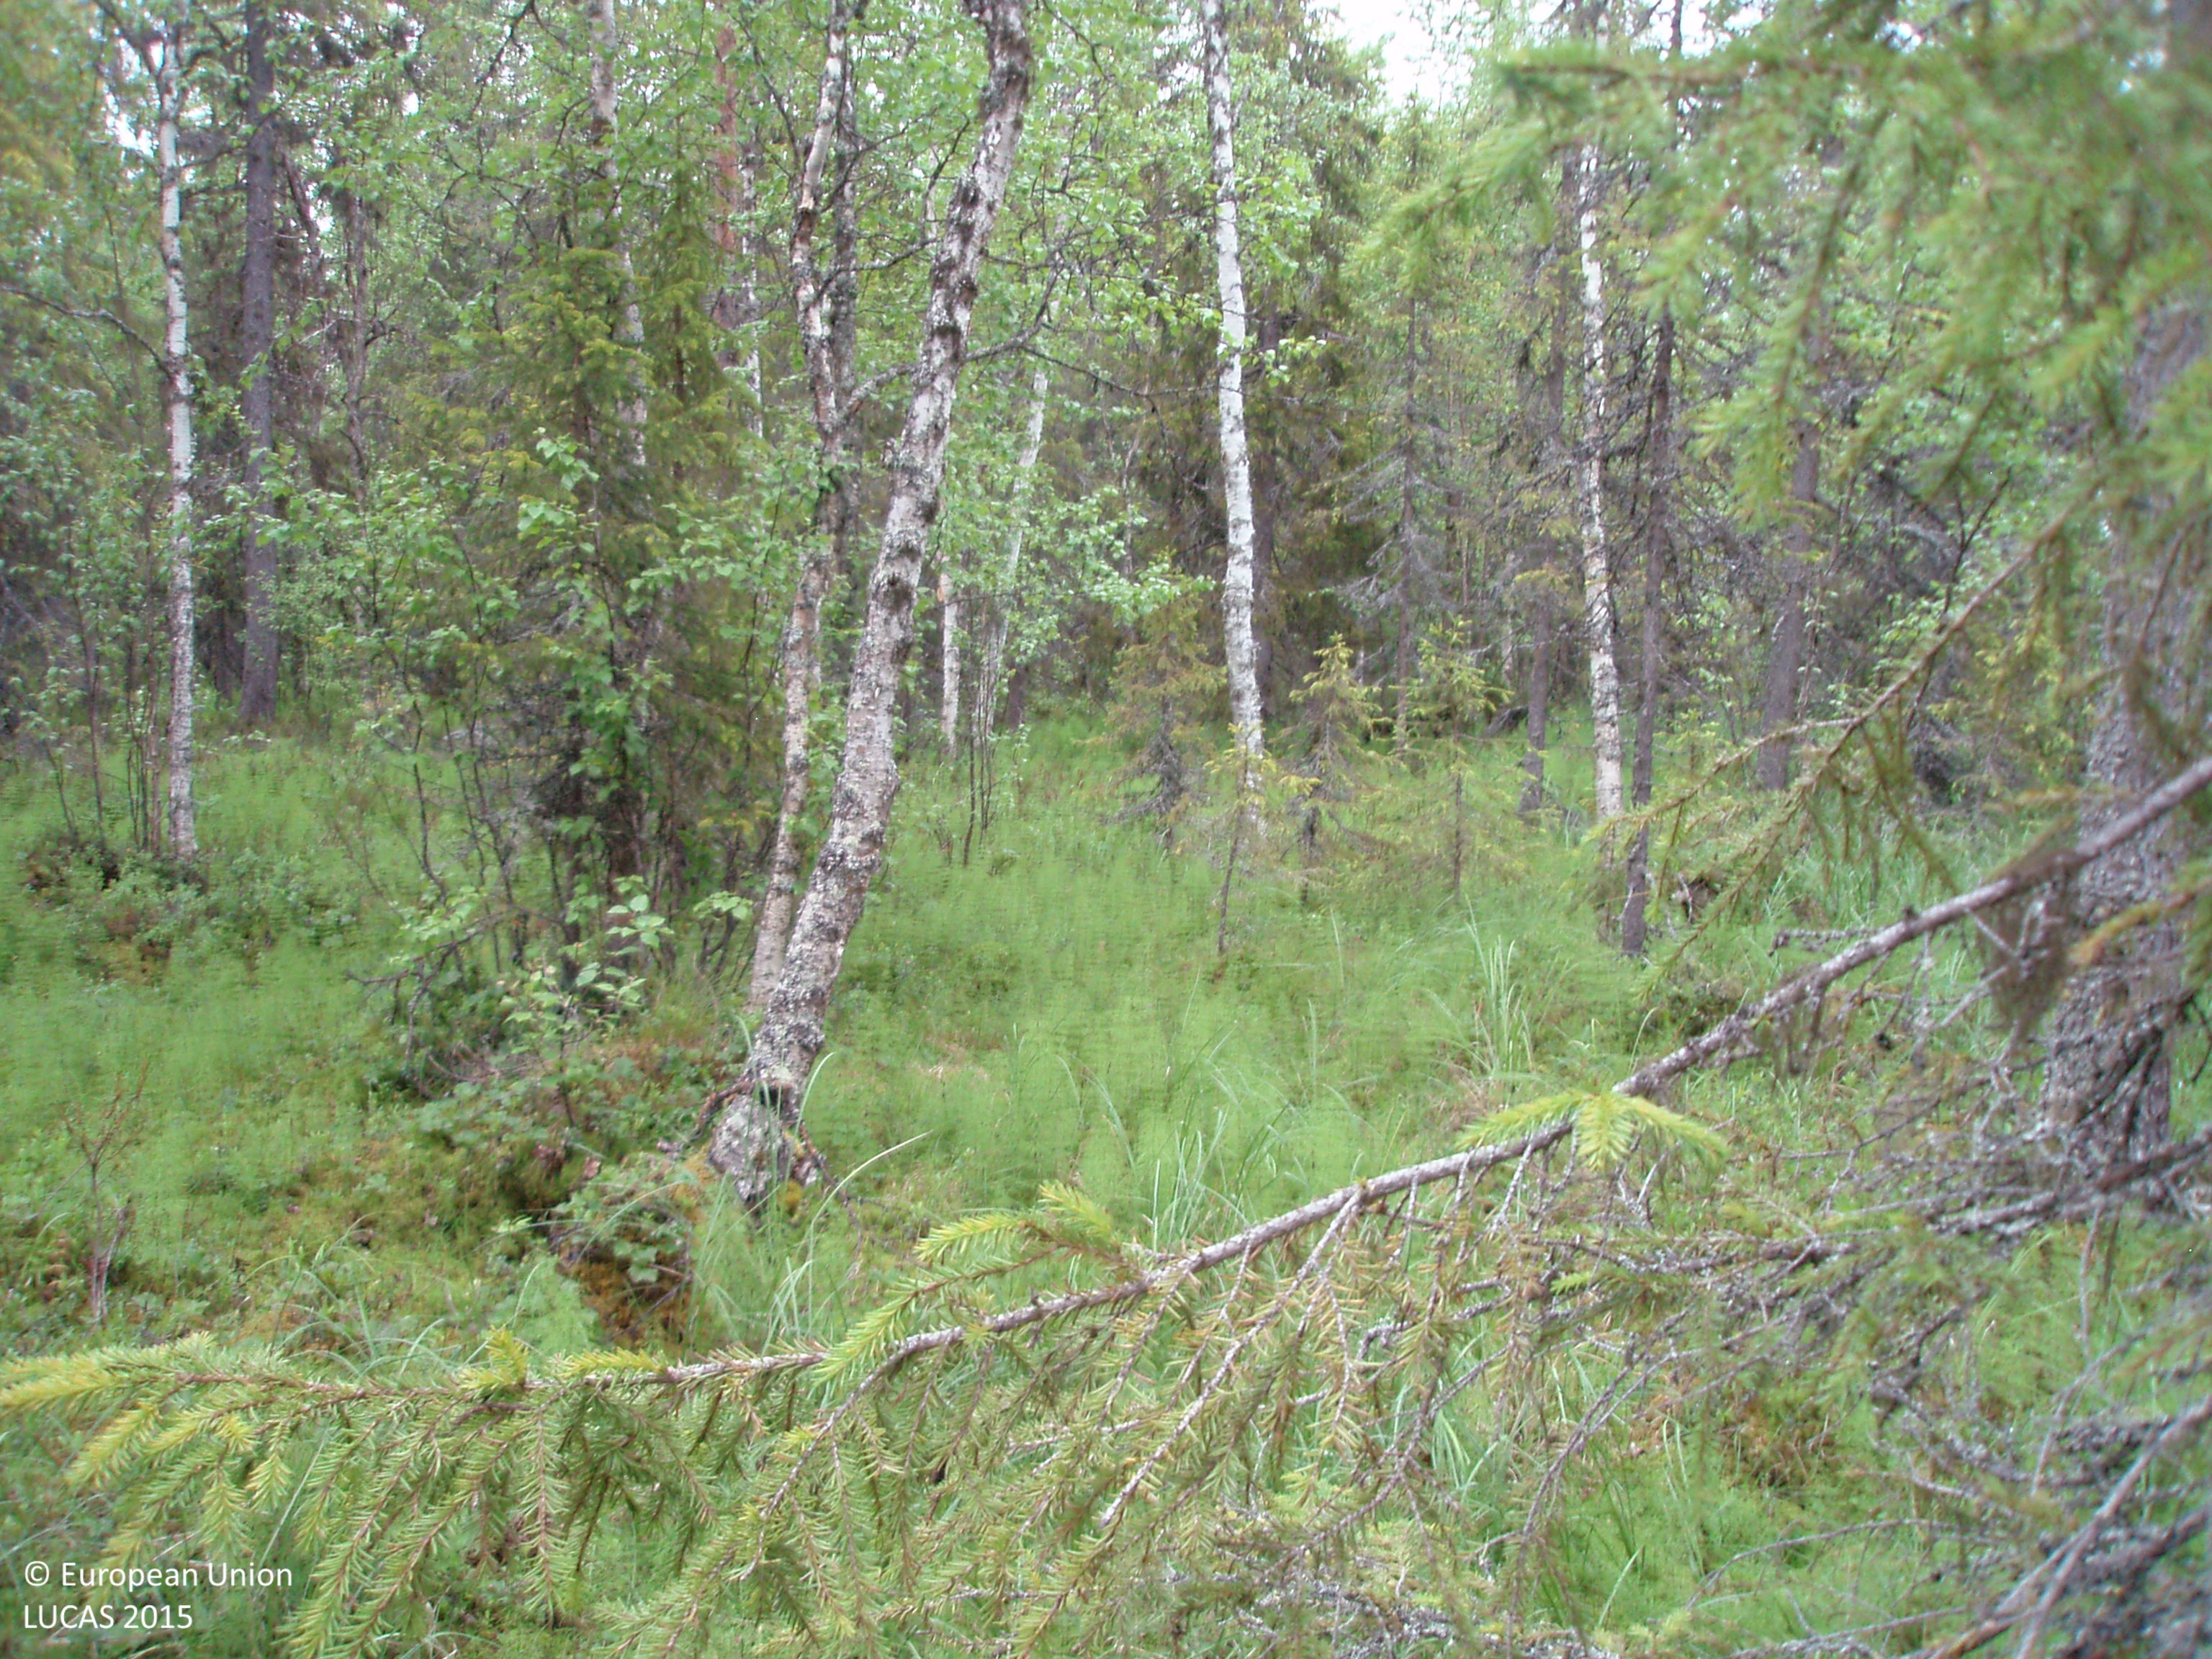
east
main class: Woodland
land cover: Spruce dominated mixed woodland
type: boreal forest
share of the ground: 50 - 75 %
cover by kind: coniferous forest trees 40 %, broadleaved forest trees 20 %, shrubs 20 %, herbaceous plants 20 %
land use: Forestry
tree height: > 5 m
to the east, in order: Spruce dominated mixed woodland; Broadleaved woodland; Ditches and canals; Broadleaved woodland; Tracks; Shruby margins; Ditches and canals; Broadleaved woodland
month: July
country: FI
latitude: 67.2714
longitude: 28.2381
